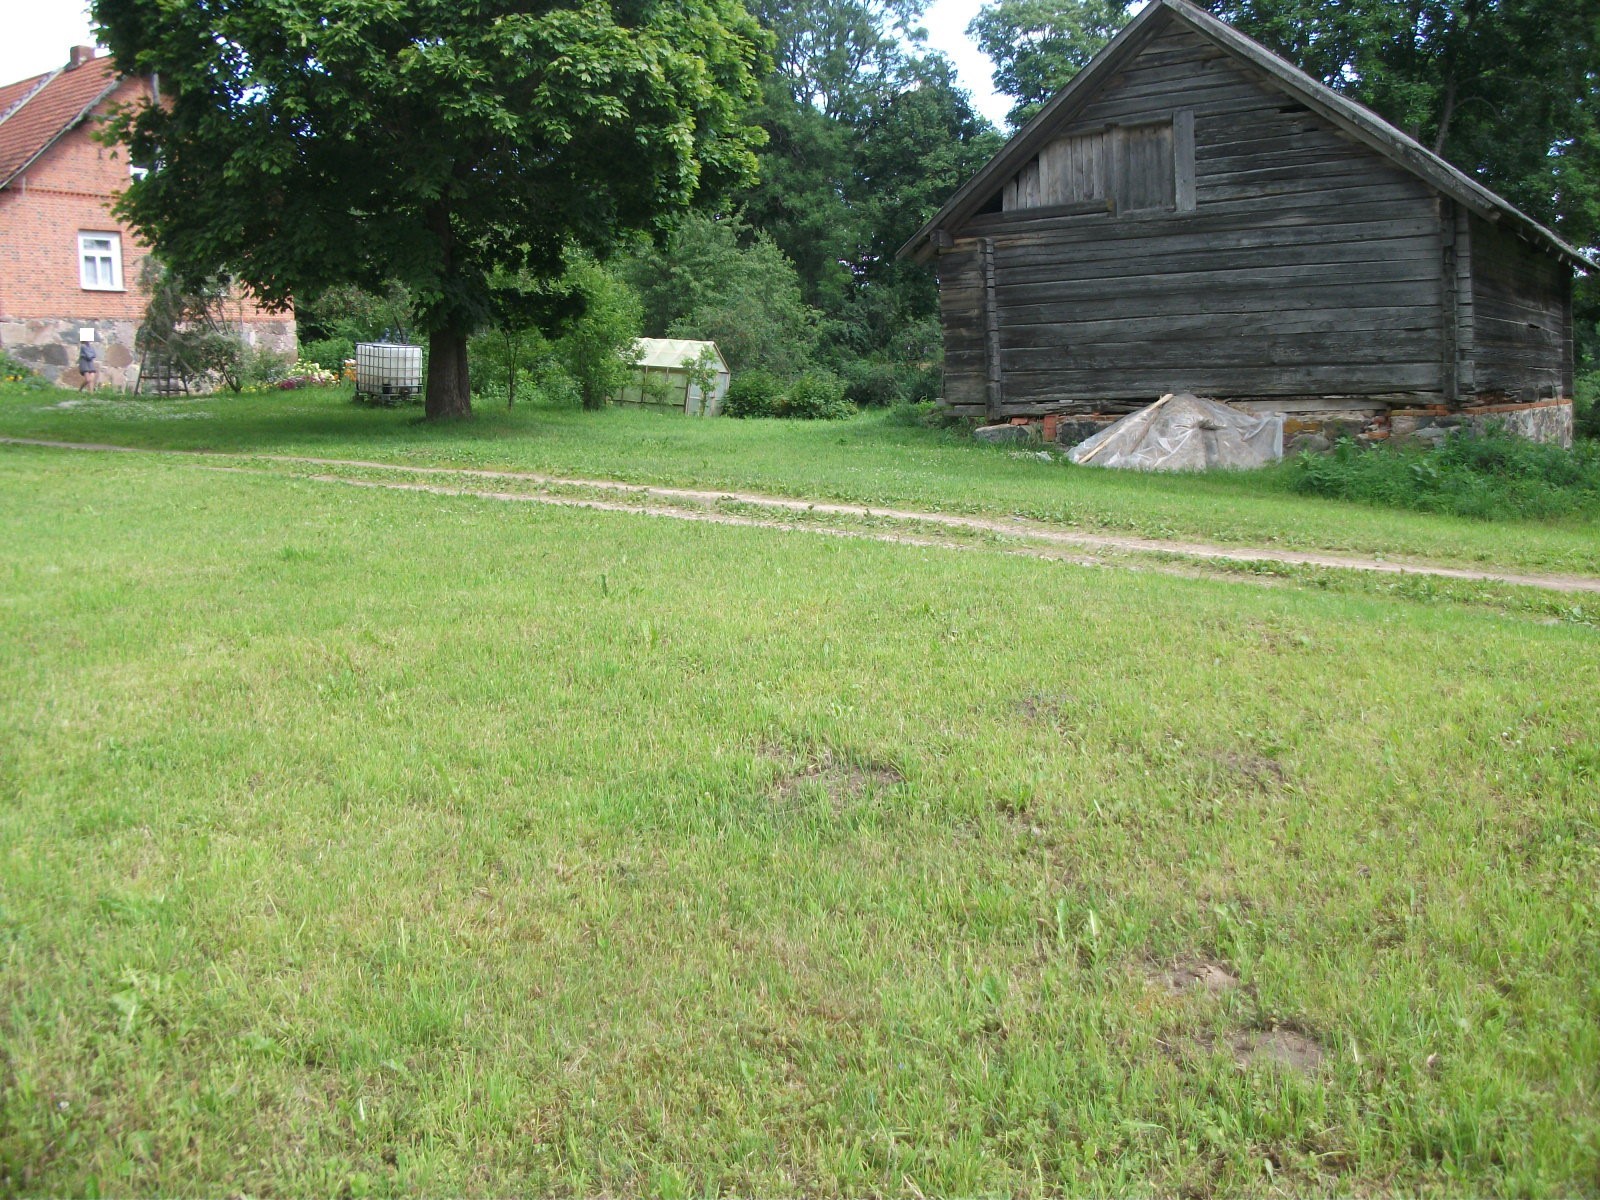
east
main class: Grassland
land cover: Grassland without tree/shrub cover
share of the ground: > 75 %
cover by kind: herbaceous plants 100 %
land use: Residential
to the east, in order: Grassland without tree/shrub cover; Tracks; Grassland without tree/shrub cover; Single bushes/trees; Grassland without tree/shrub cover; Broadleaved woodland; Grassland without tree/shrub cover; Broadleaved woodland; Grass margins; Barley
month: July
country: LV
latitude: 57.0121
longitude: 26.2944
